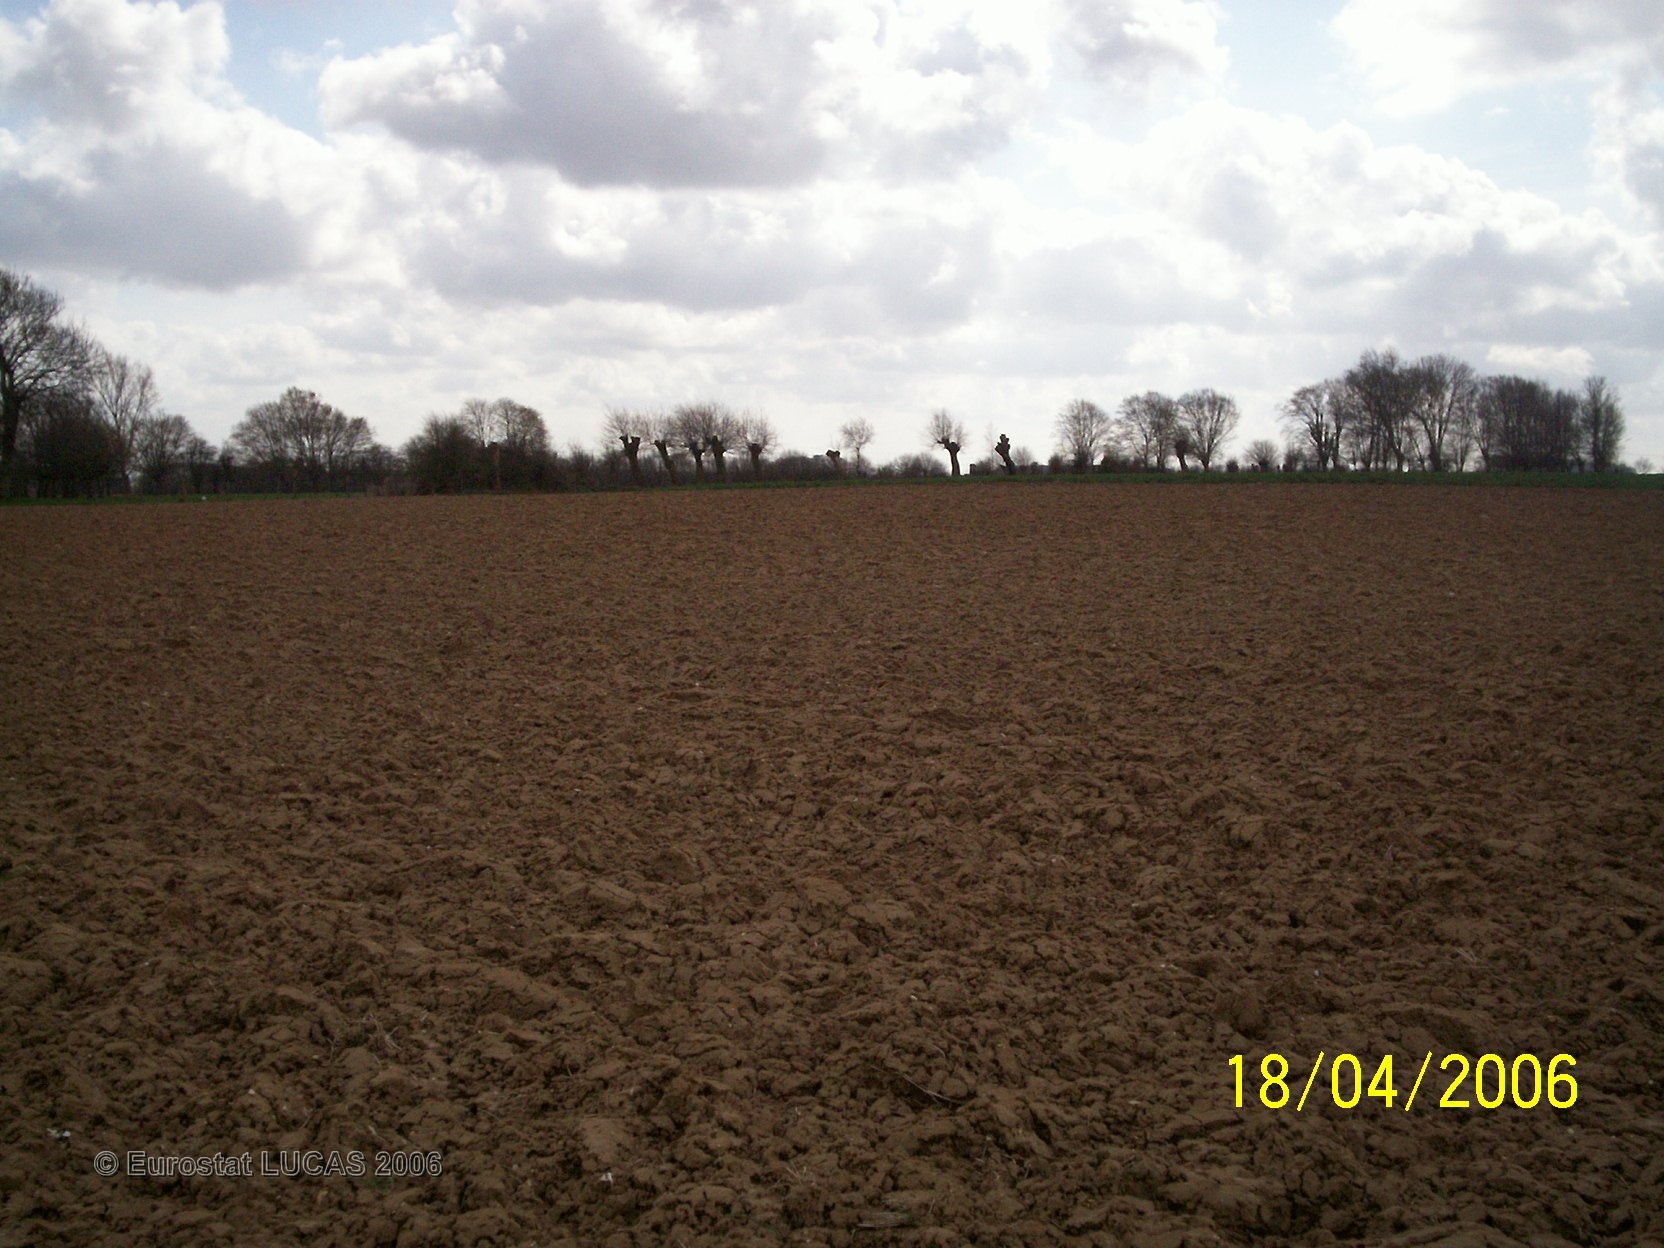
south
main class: Cropland
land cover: Maize
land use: Agriculture (excluding fallow land and kitchen gardens)
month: June
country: FR
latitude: 50.3540
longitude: 2.5244
